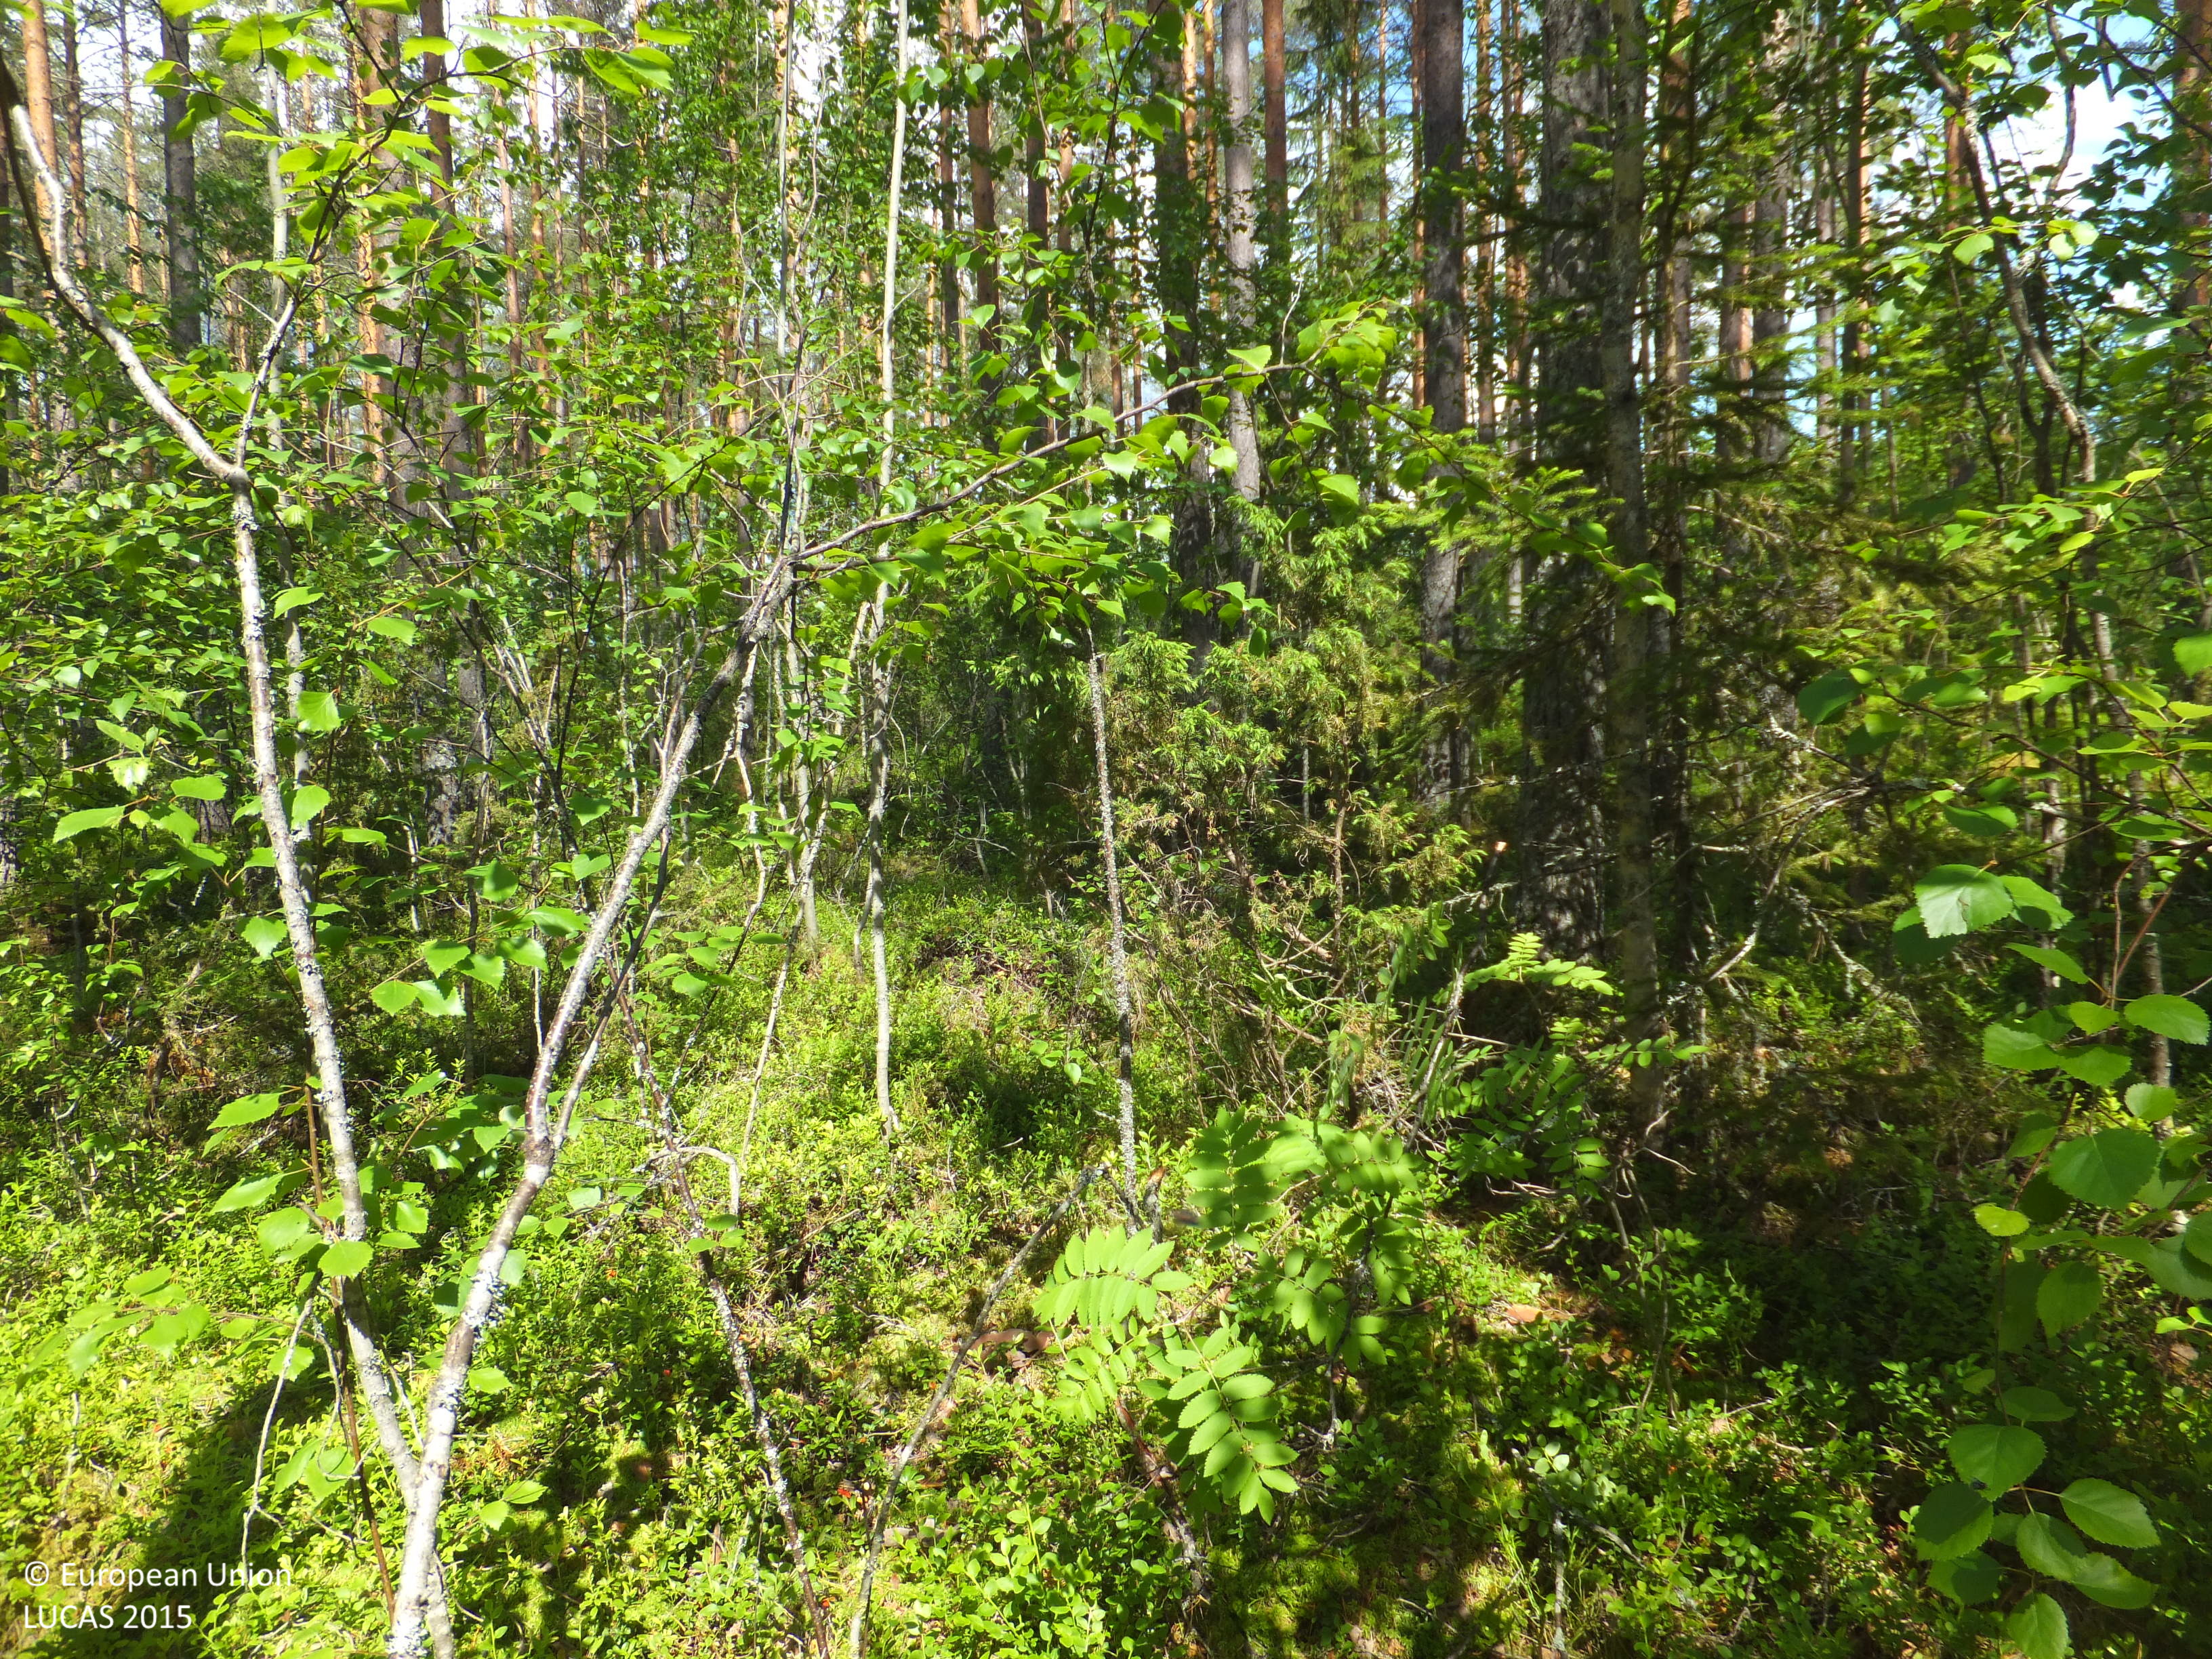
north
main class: Woodland
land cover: Pine dominated mixed woodland
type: boreal forest
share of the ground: 50 - 75 %
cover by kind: coniferous forest trees 35 %, broadleaved forest trees 25 %, shrubs 20 %, herbaceous plants 10 %, lichens and mosses 10 %
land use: Forestry
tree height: > 5 m
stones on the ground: 25 - 50 %
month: June
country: FI
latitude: 63.2024
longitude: 24.0105
